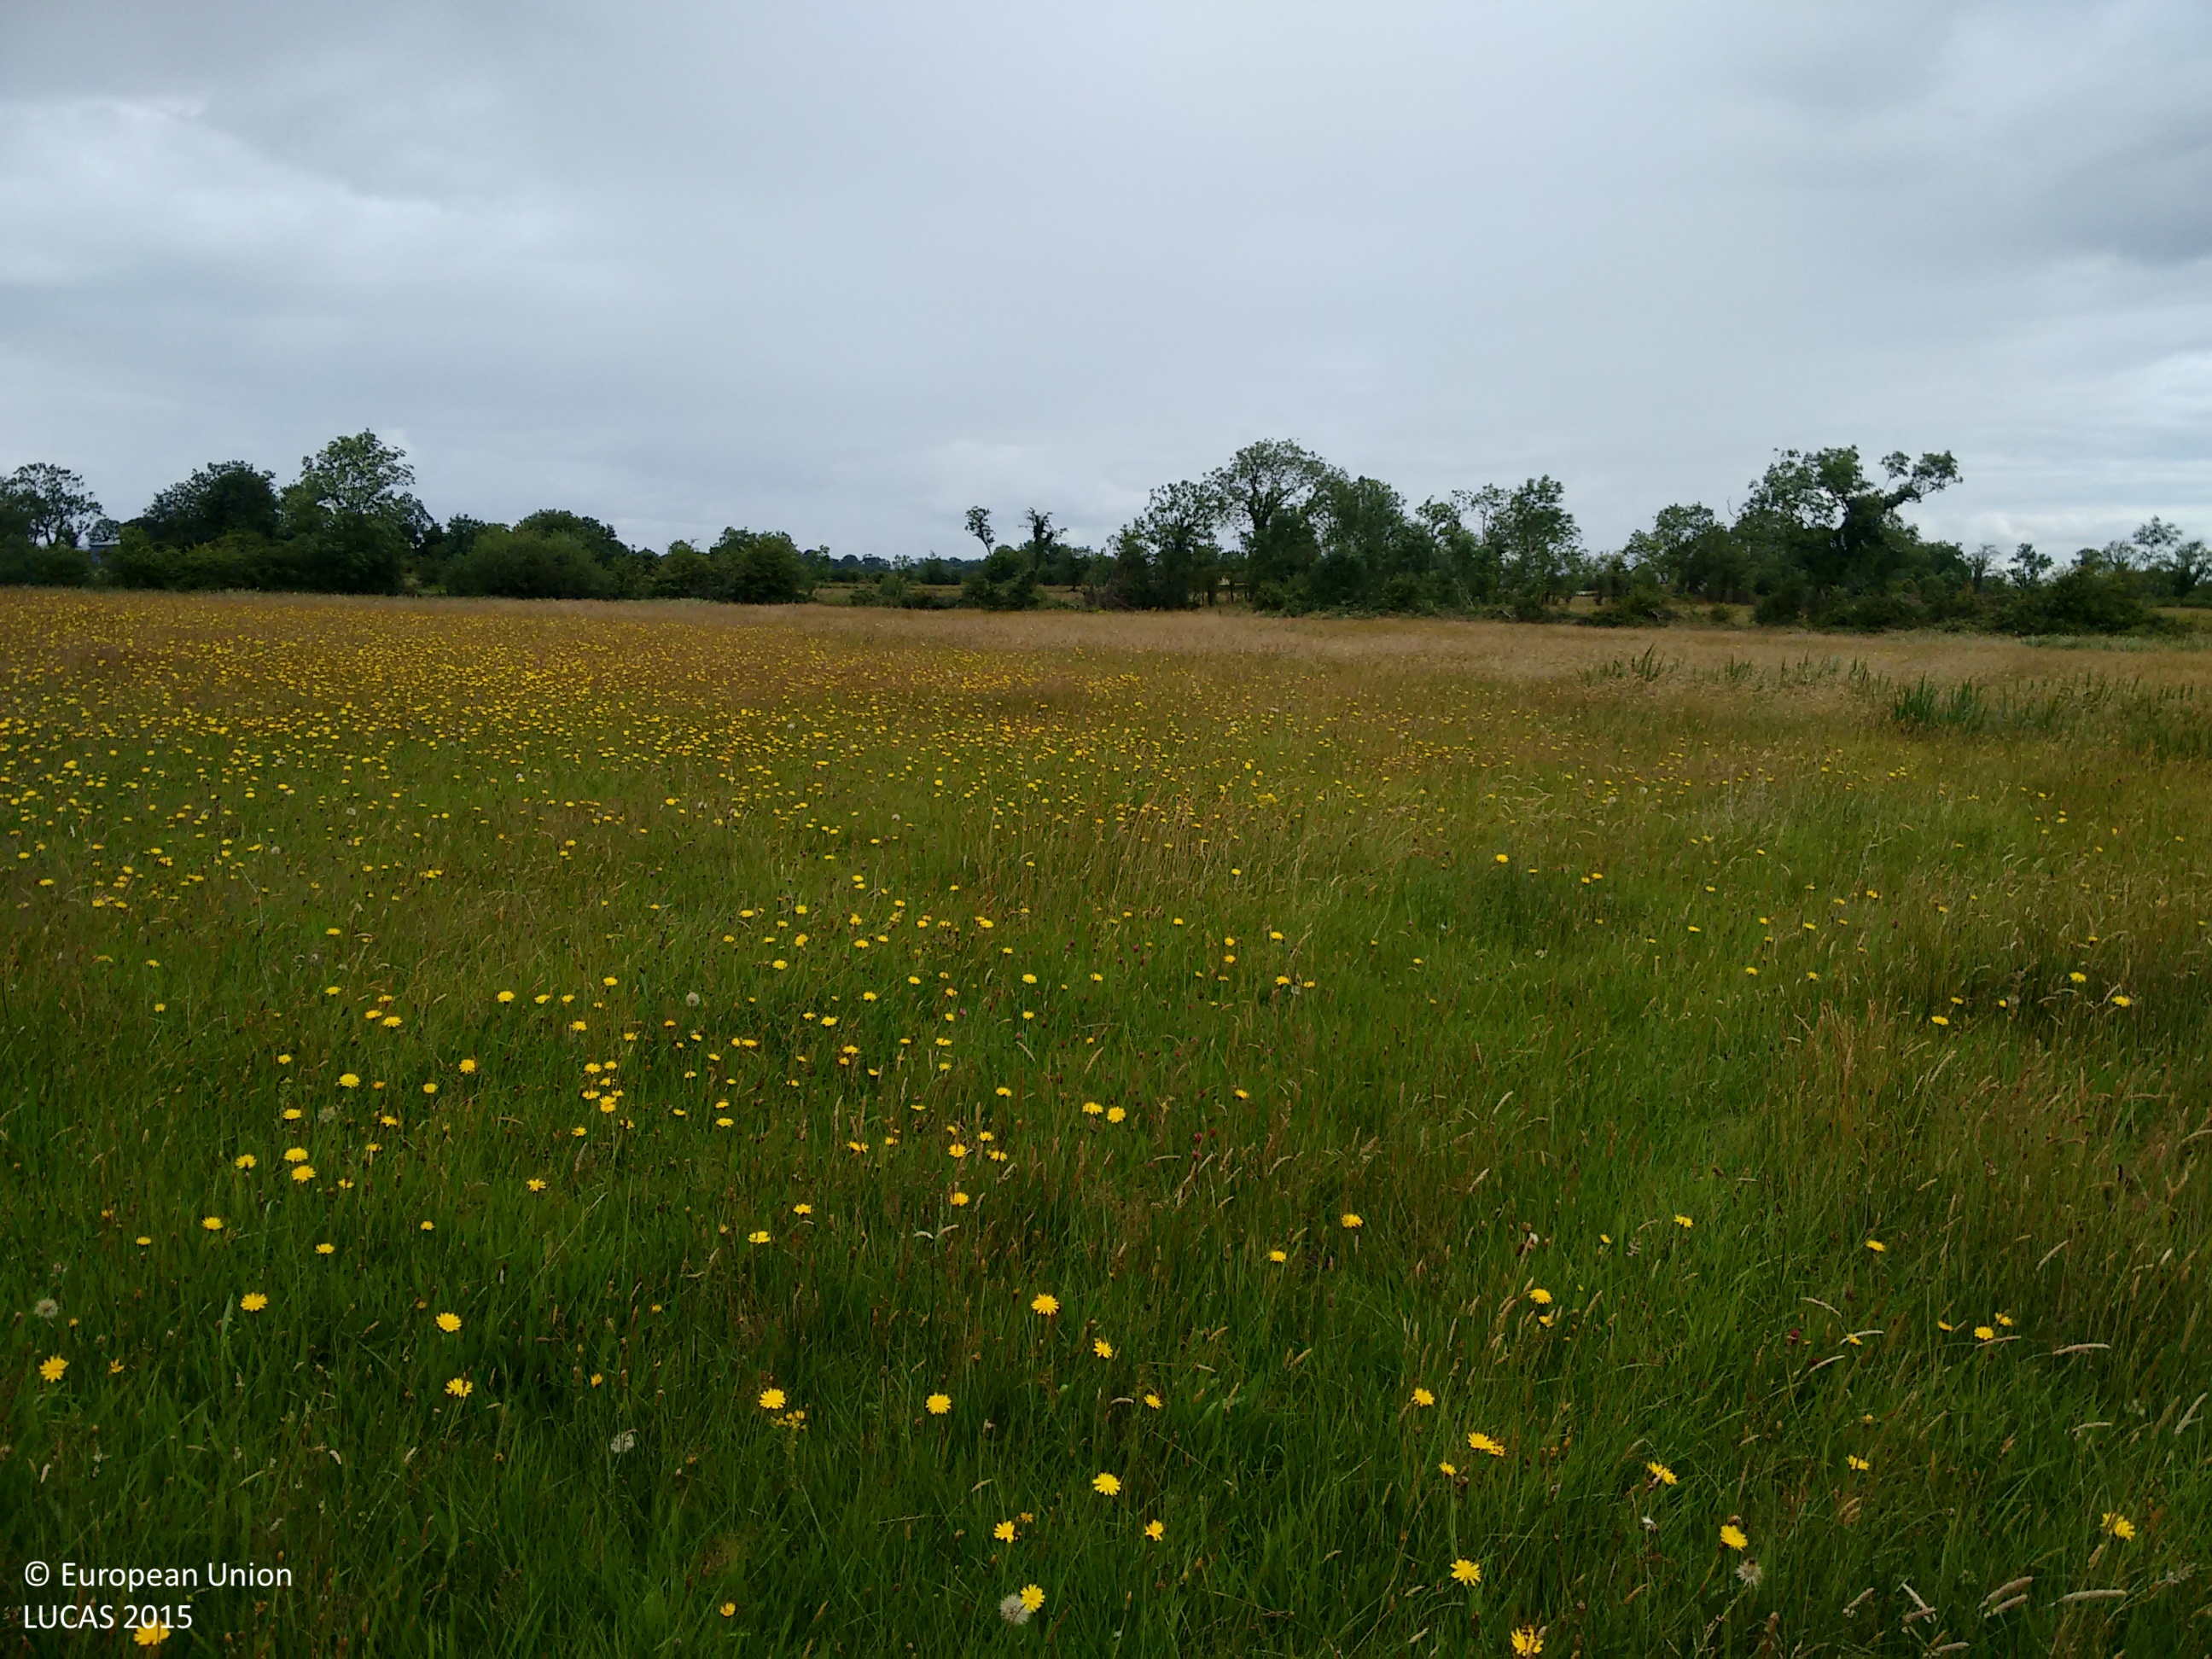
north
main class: Grassland
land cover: Grassland without tree/shrub cover
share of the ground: > 75 %
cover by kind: herbaceous plants 95 %, shrubs 5 %
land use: Agriculture (excluding fallow land and kitchen gardens)
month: July
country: IE
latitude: 53.7194
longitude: -7.7287
